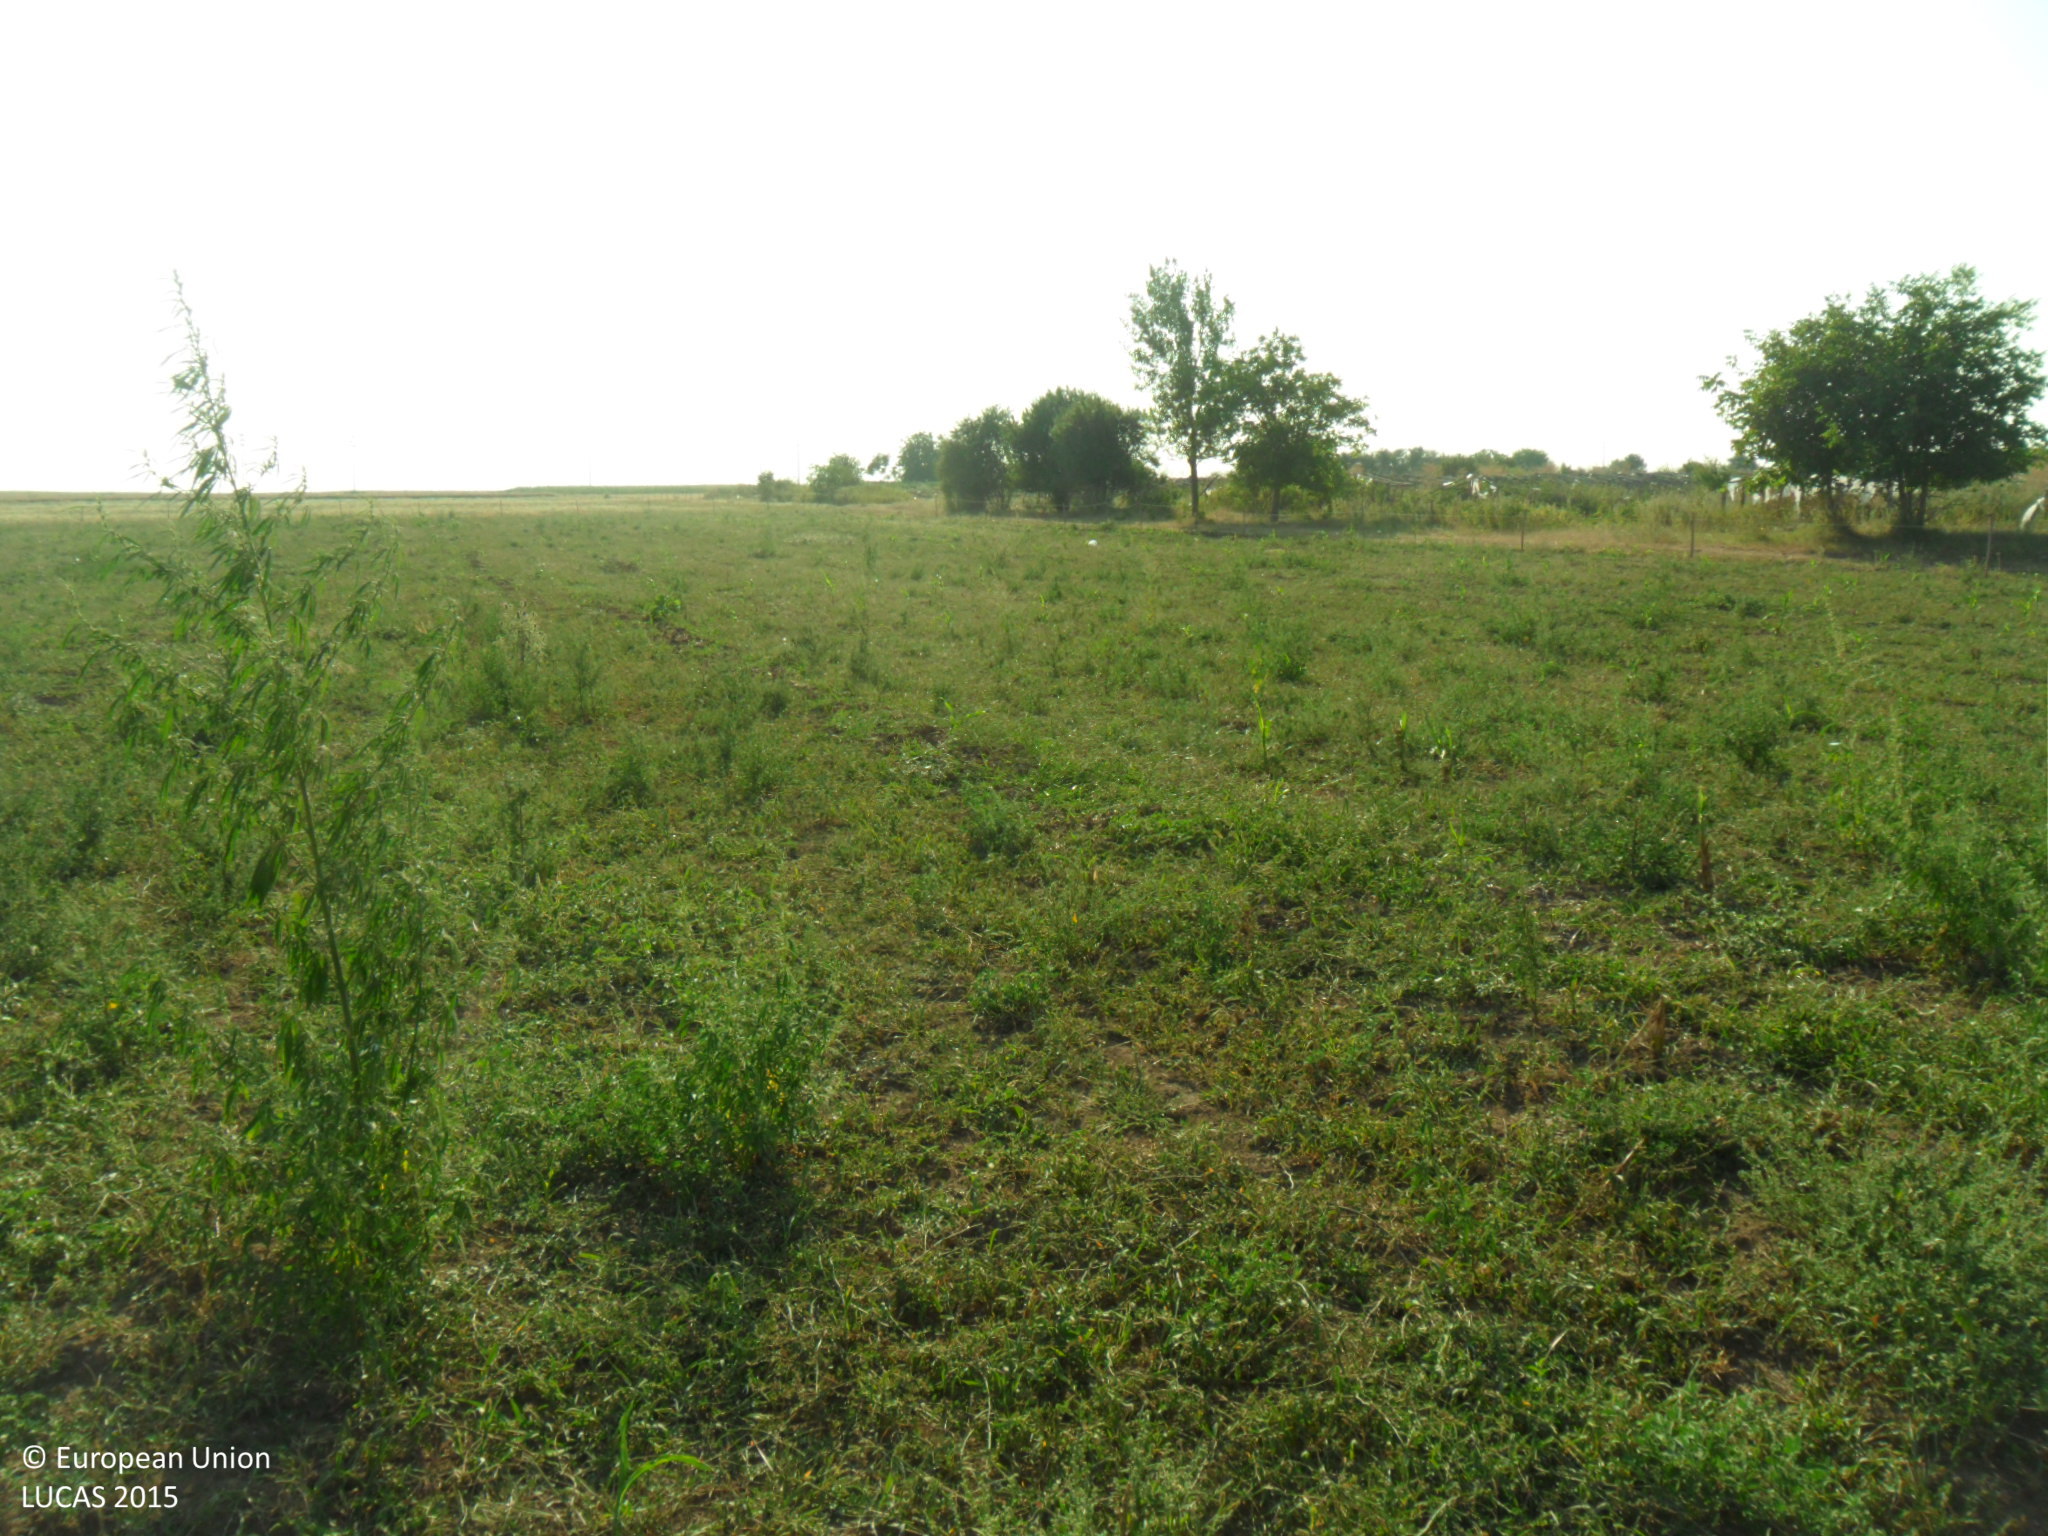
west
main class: Cropland
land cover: Maize
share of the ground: 10 - 25 %
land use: Agriculture (excluding fallow land and kitchen gardens)
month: July
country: BG
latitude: 43.6942
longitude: 27.0828
